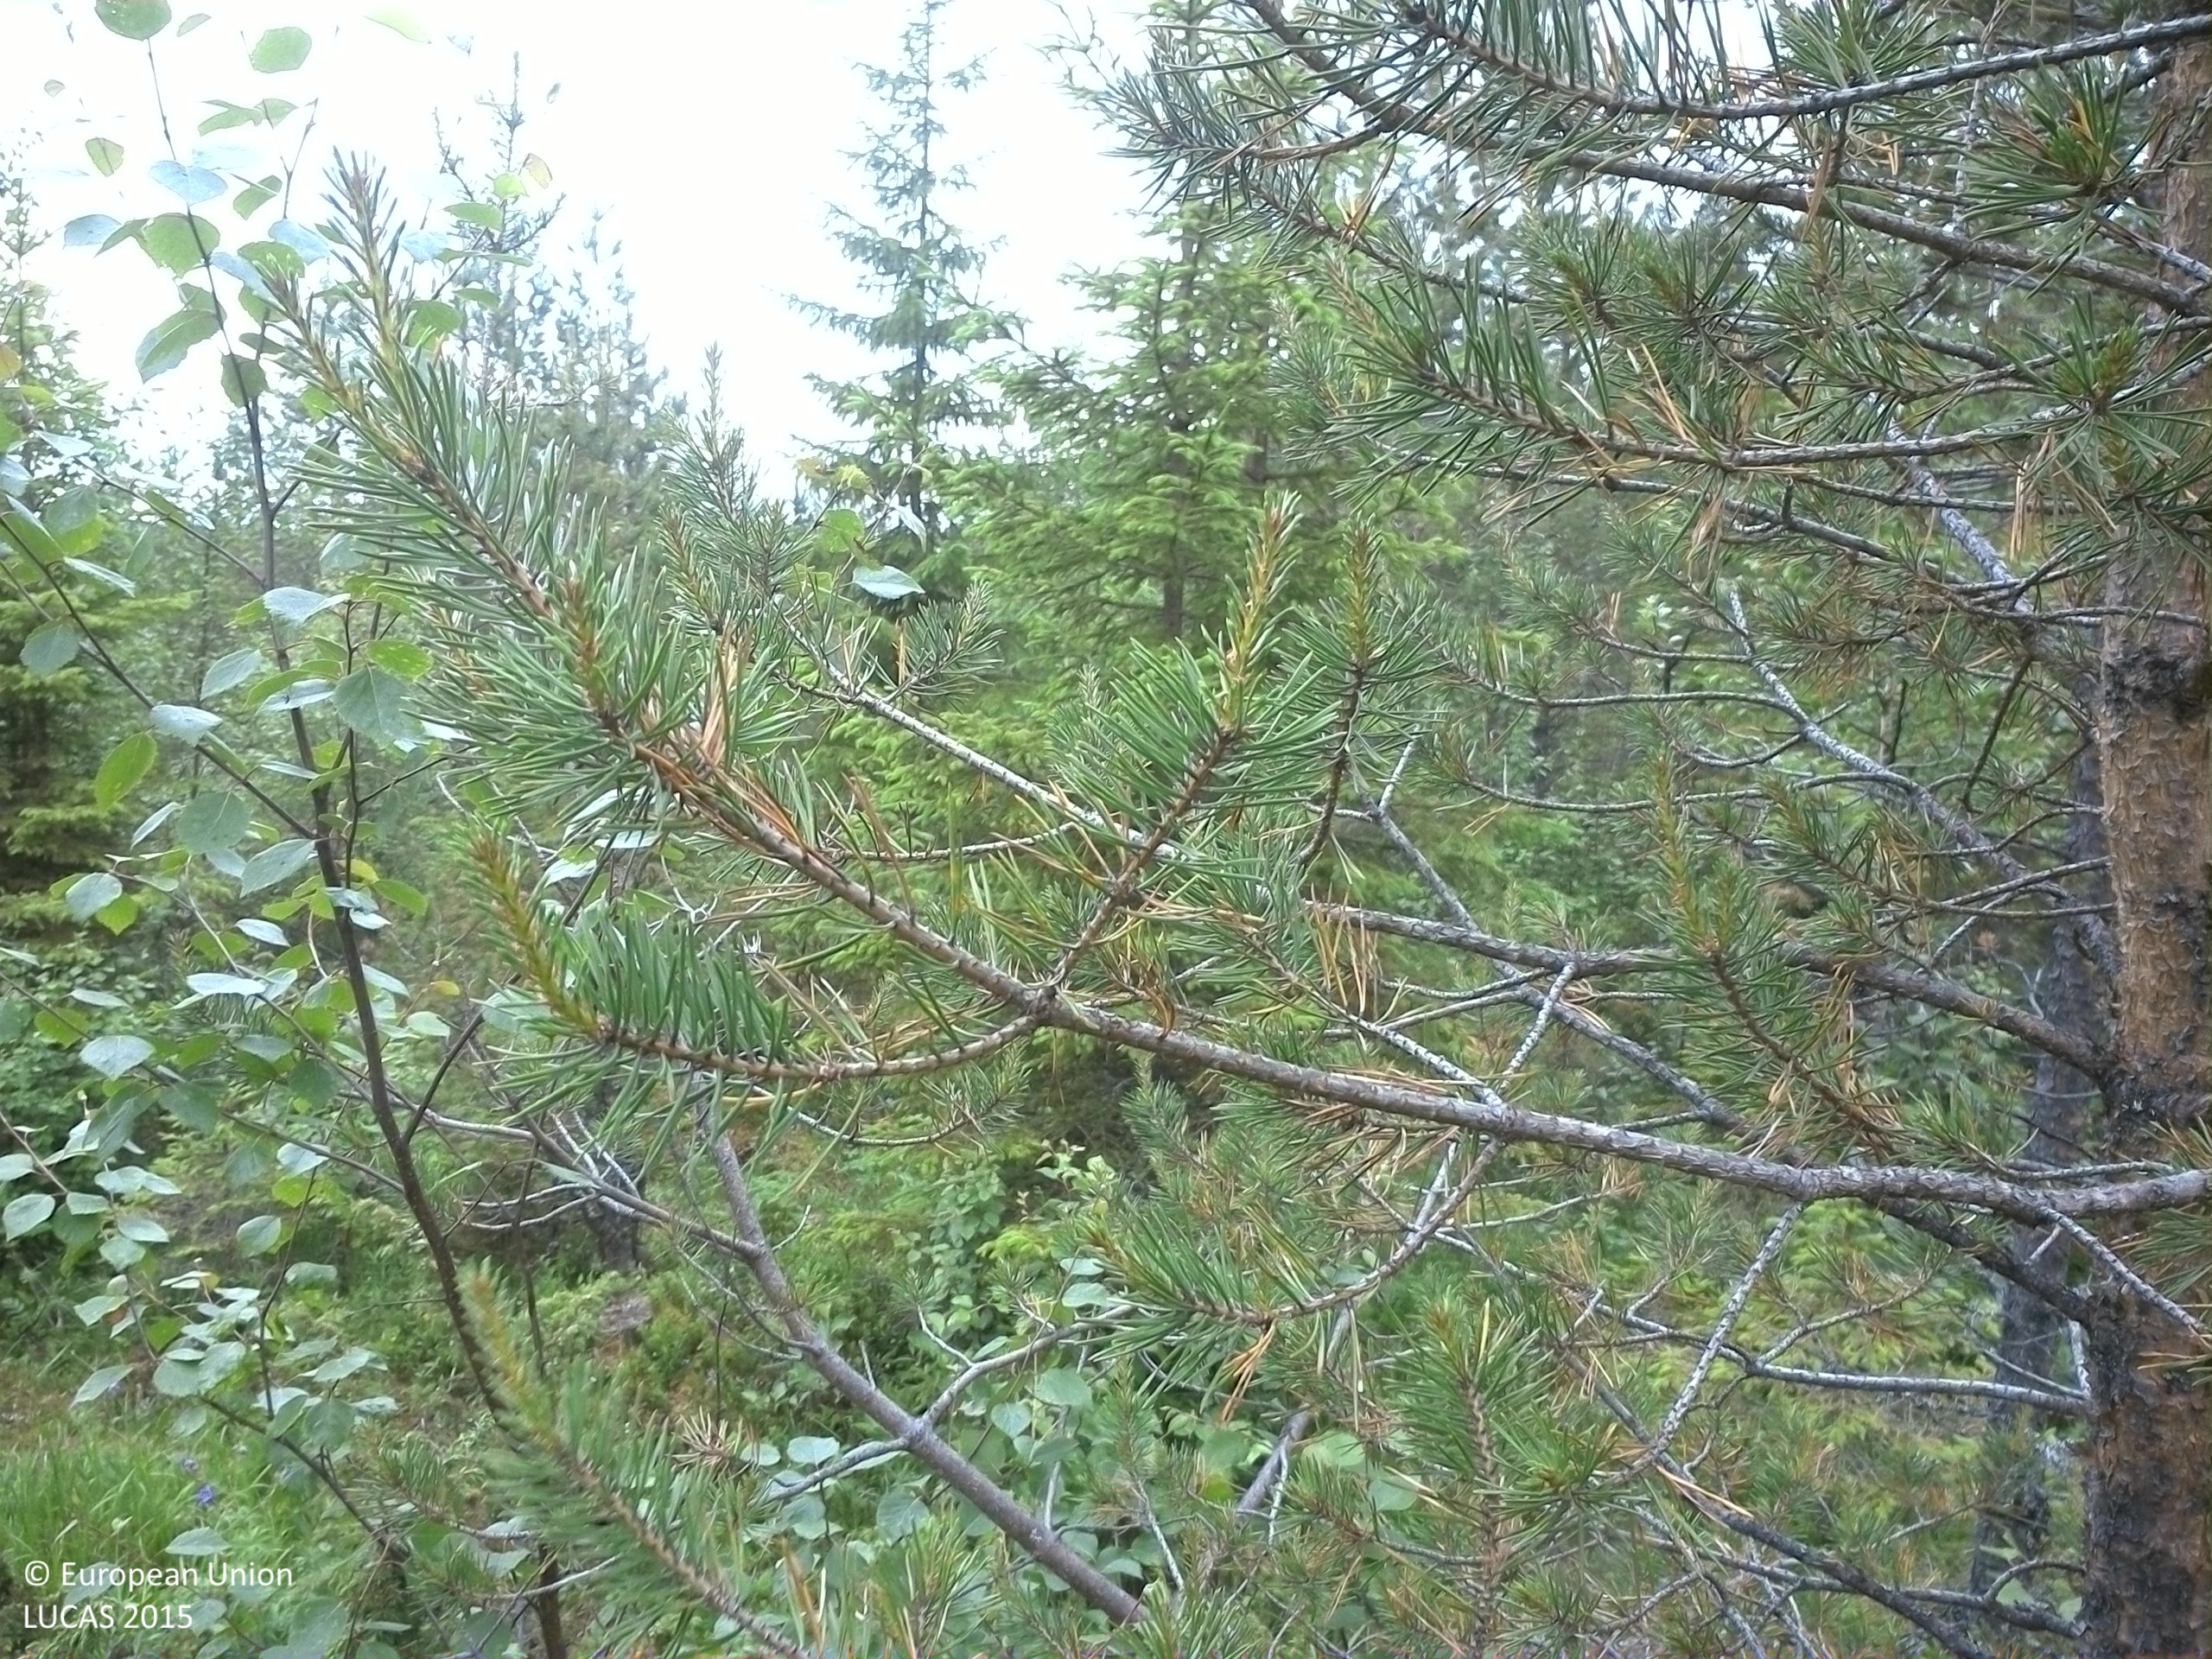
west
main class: Woodland
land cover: Pine dominated mixed woodland
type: boreal forest
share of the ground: 25 - 50 %
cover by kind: coniferous forest trees 30 %, shrubs 30 %, broadleaved forest trees 15 %, herbaceous plants 10 %, lichens and mosses 10 %, consolidated bare surface 5 %
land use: Forestry
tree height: < 5 m
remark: Clear cut
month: July
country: SE
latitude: 64.4292
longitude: 16.0117
